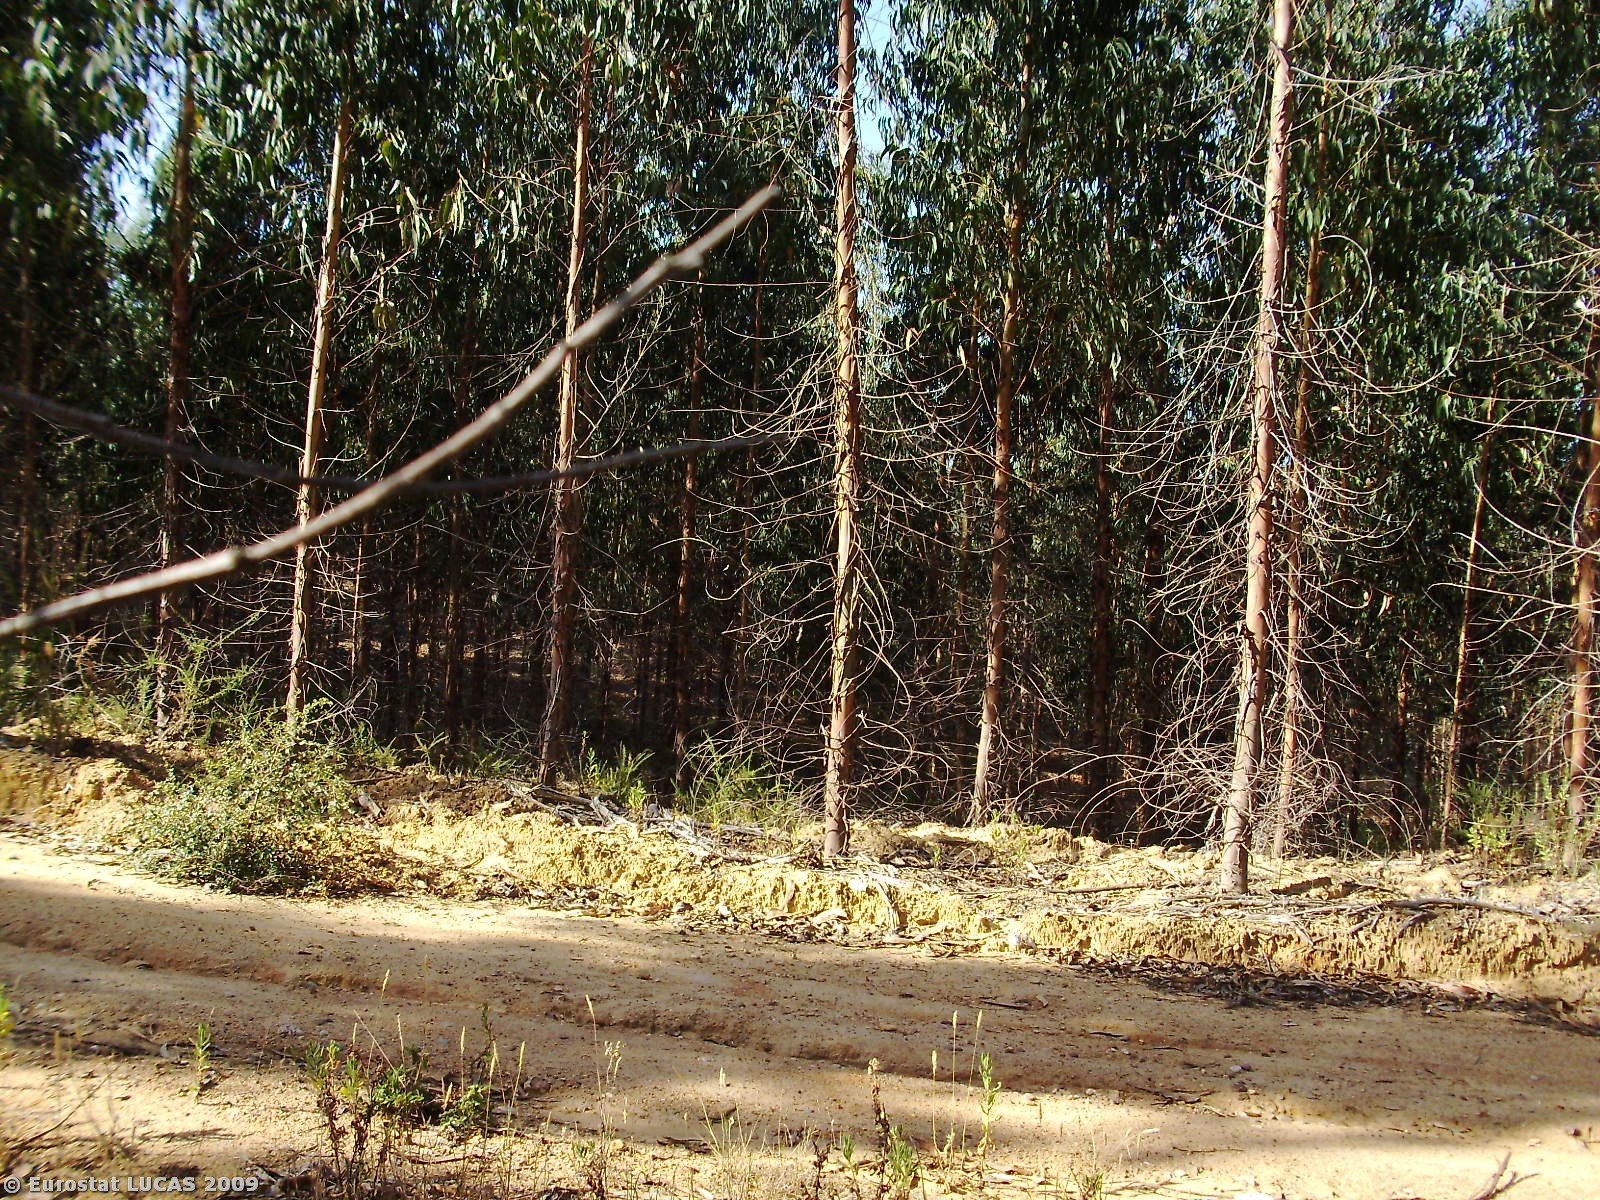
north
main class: Woodland
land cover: Broadleaved woodland
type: plantations and self-sown exotic forest
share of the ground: > 75 %
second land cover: Bare land
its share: 10 - 25 %
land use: Forestry
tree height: > 5 m
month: July
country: PT
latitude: 39.3532
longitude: -8.8201
